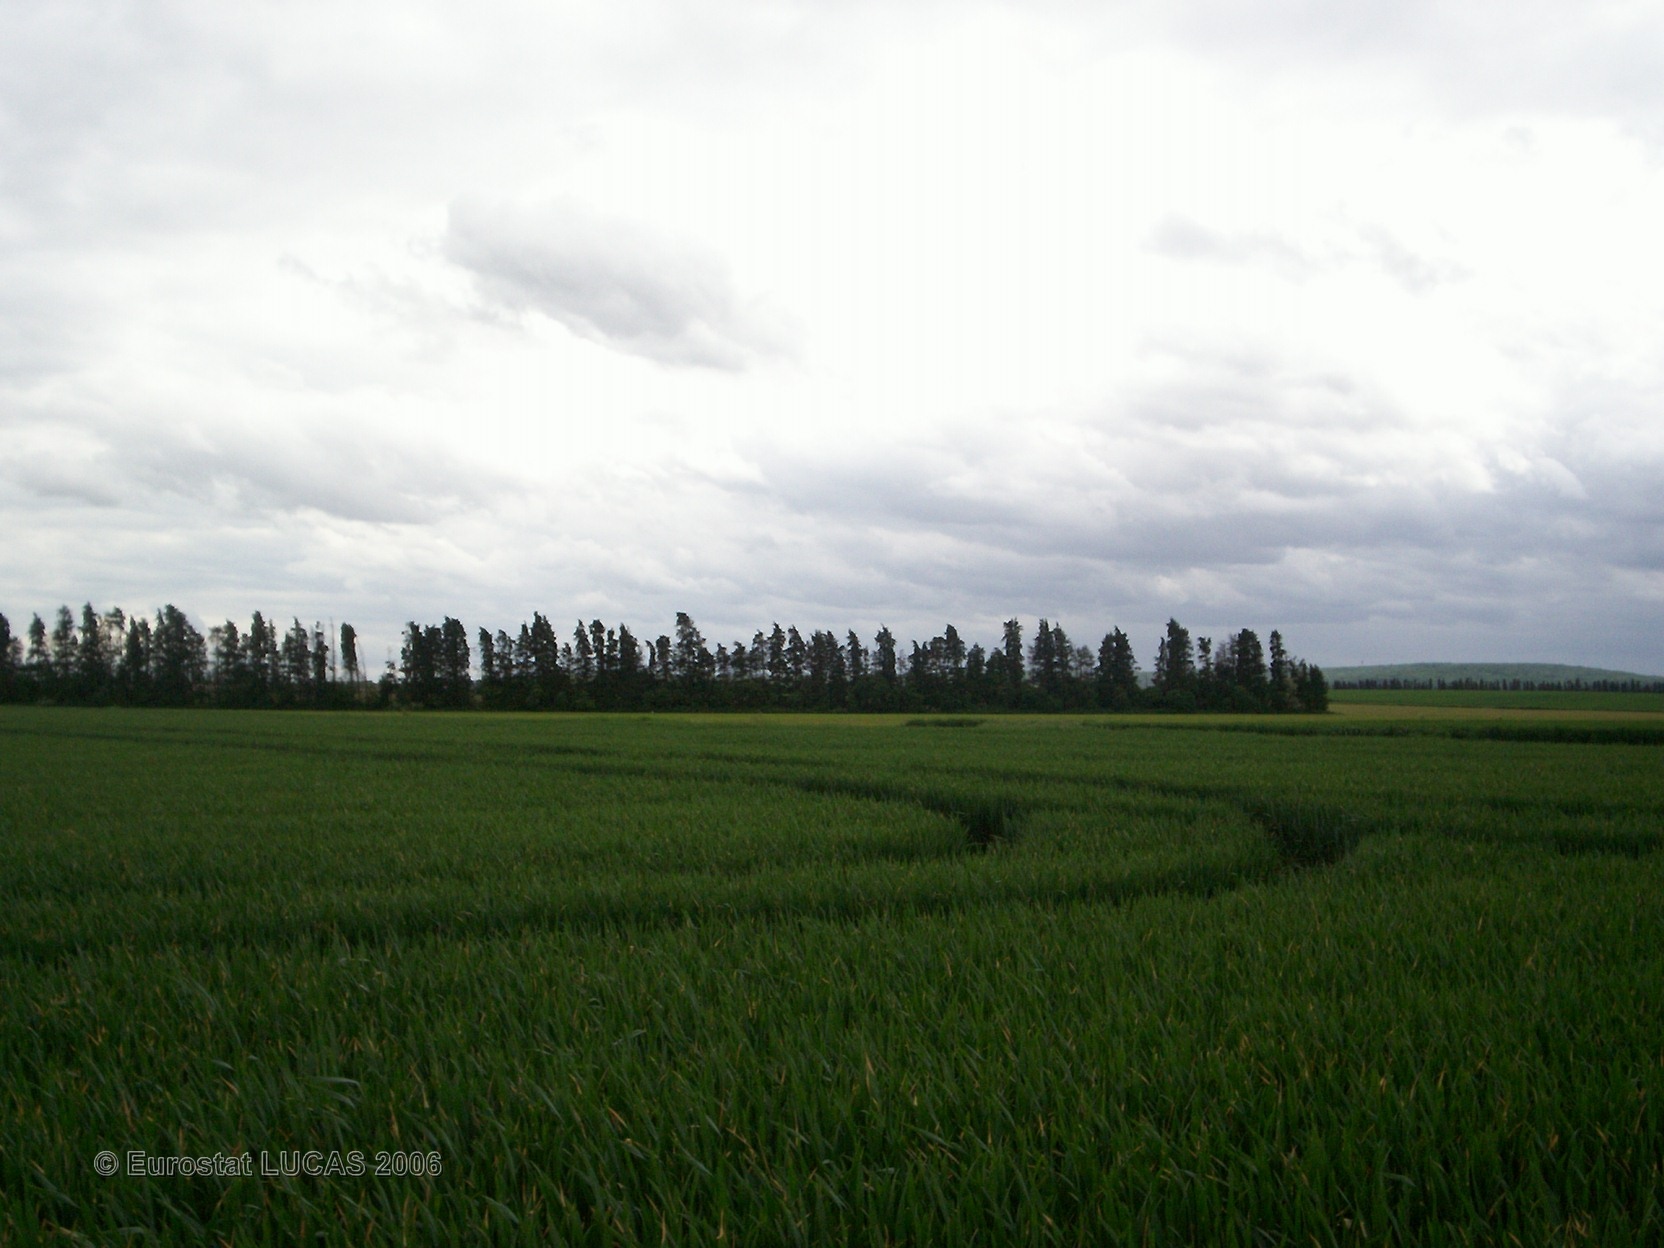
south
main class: Cropland
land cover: Common wheat
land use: Agriculture (excluding fallow land and kitchen gardens)
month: May
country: FR
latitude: 49.0881
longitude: 2.7736
